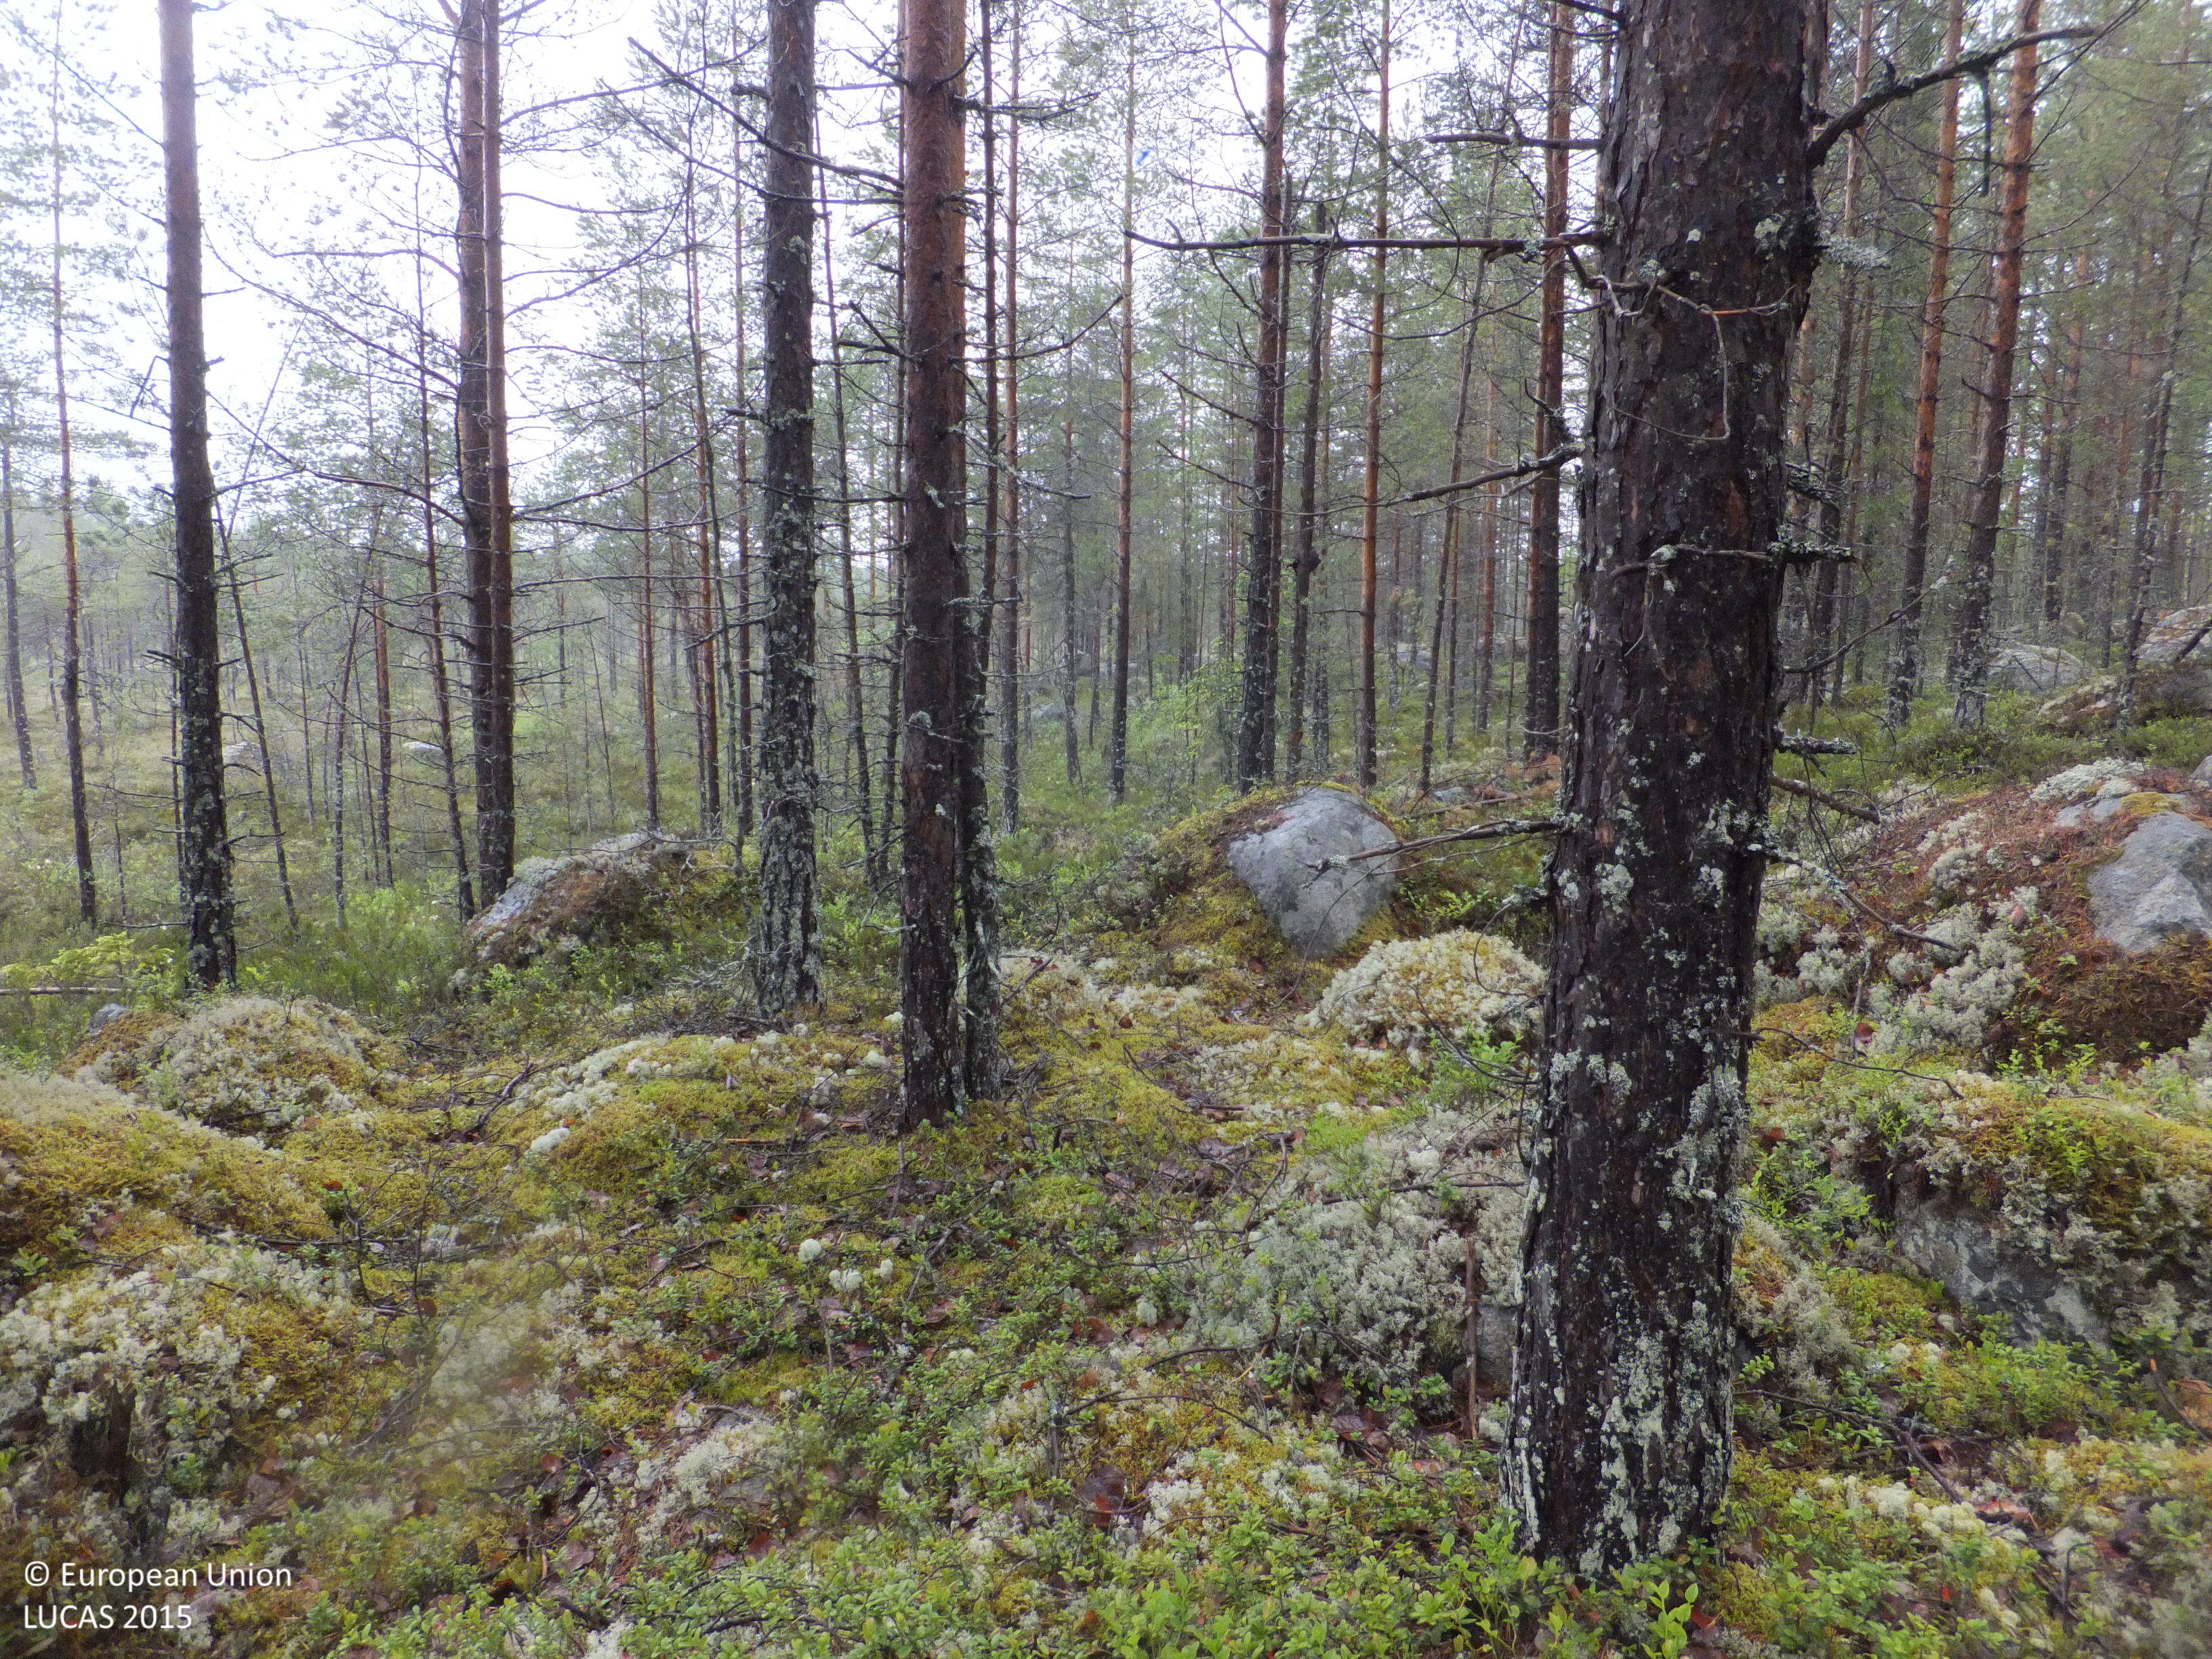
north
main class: Woodland
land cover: Pine dominated coniferous woodland
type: boreal forest
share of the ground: > 75 %
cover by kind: coniferous forest trees 70 %, shrubs 10 %, lichens and mosses 10 %, broadleaved forest trees 5 %, consolidated bare surface 5 %
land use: Forestry
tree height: > 5 m
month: June
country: FI
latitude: 63.3823
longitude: 24.8320
